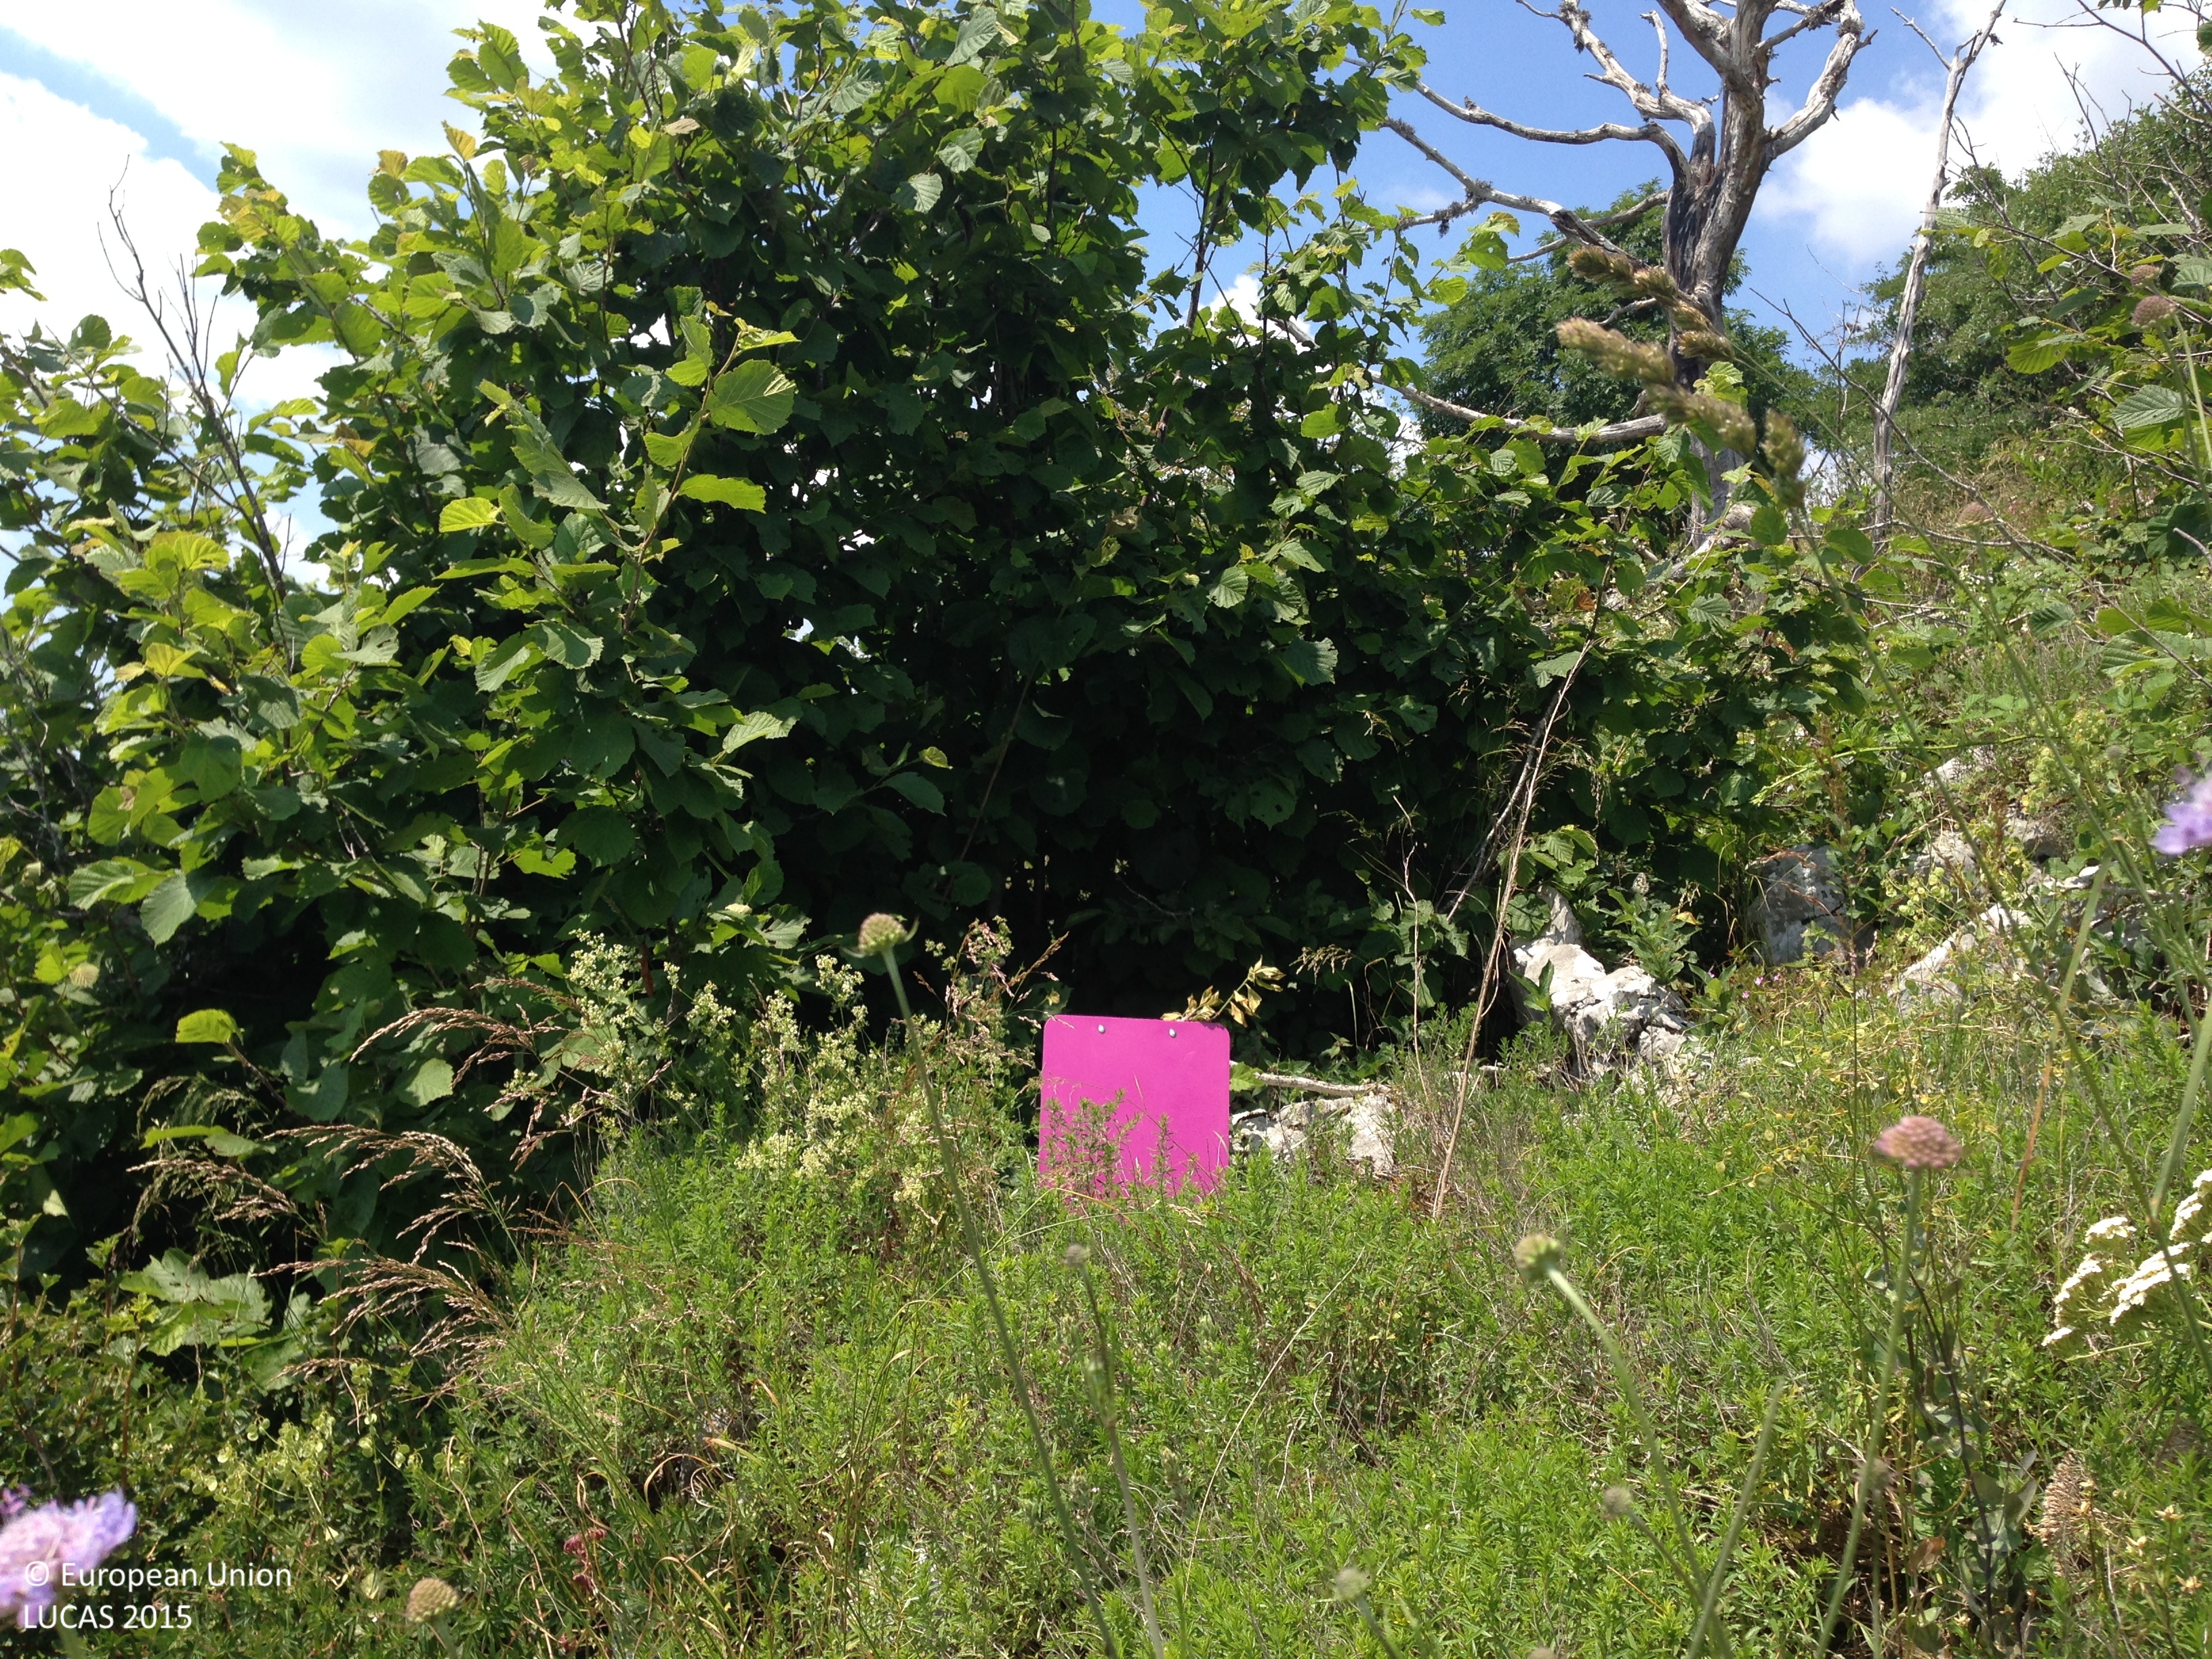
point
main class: Shrubland
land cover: Shrubland with sparse tree cover
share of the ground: 25 - 50 %
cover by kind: shrubs 35 %, herbaceous plants 35 %, consolidated bare surface 20 %, broadleaved forest trees 5 %, unconsolidated bare surface 5 %
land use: Semi-natural and natural areas not in use
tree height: < 5 m
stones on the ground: < 10 %
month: July
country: HR
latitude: 44.5843
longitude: 15.1447
